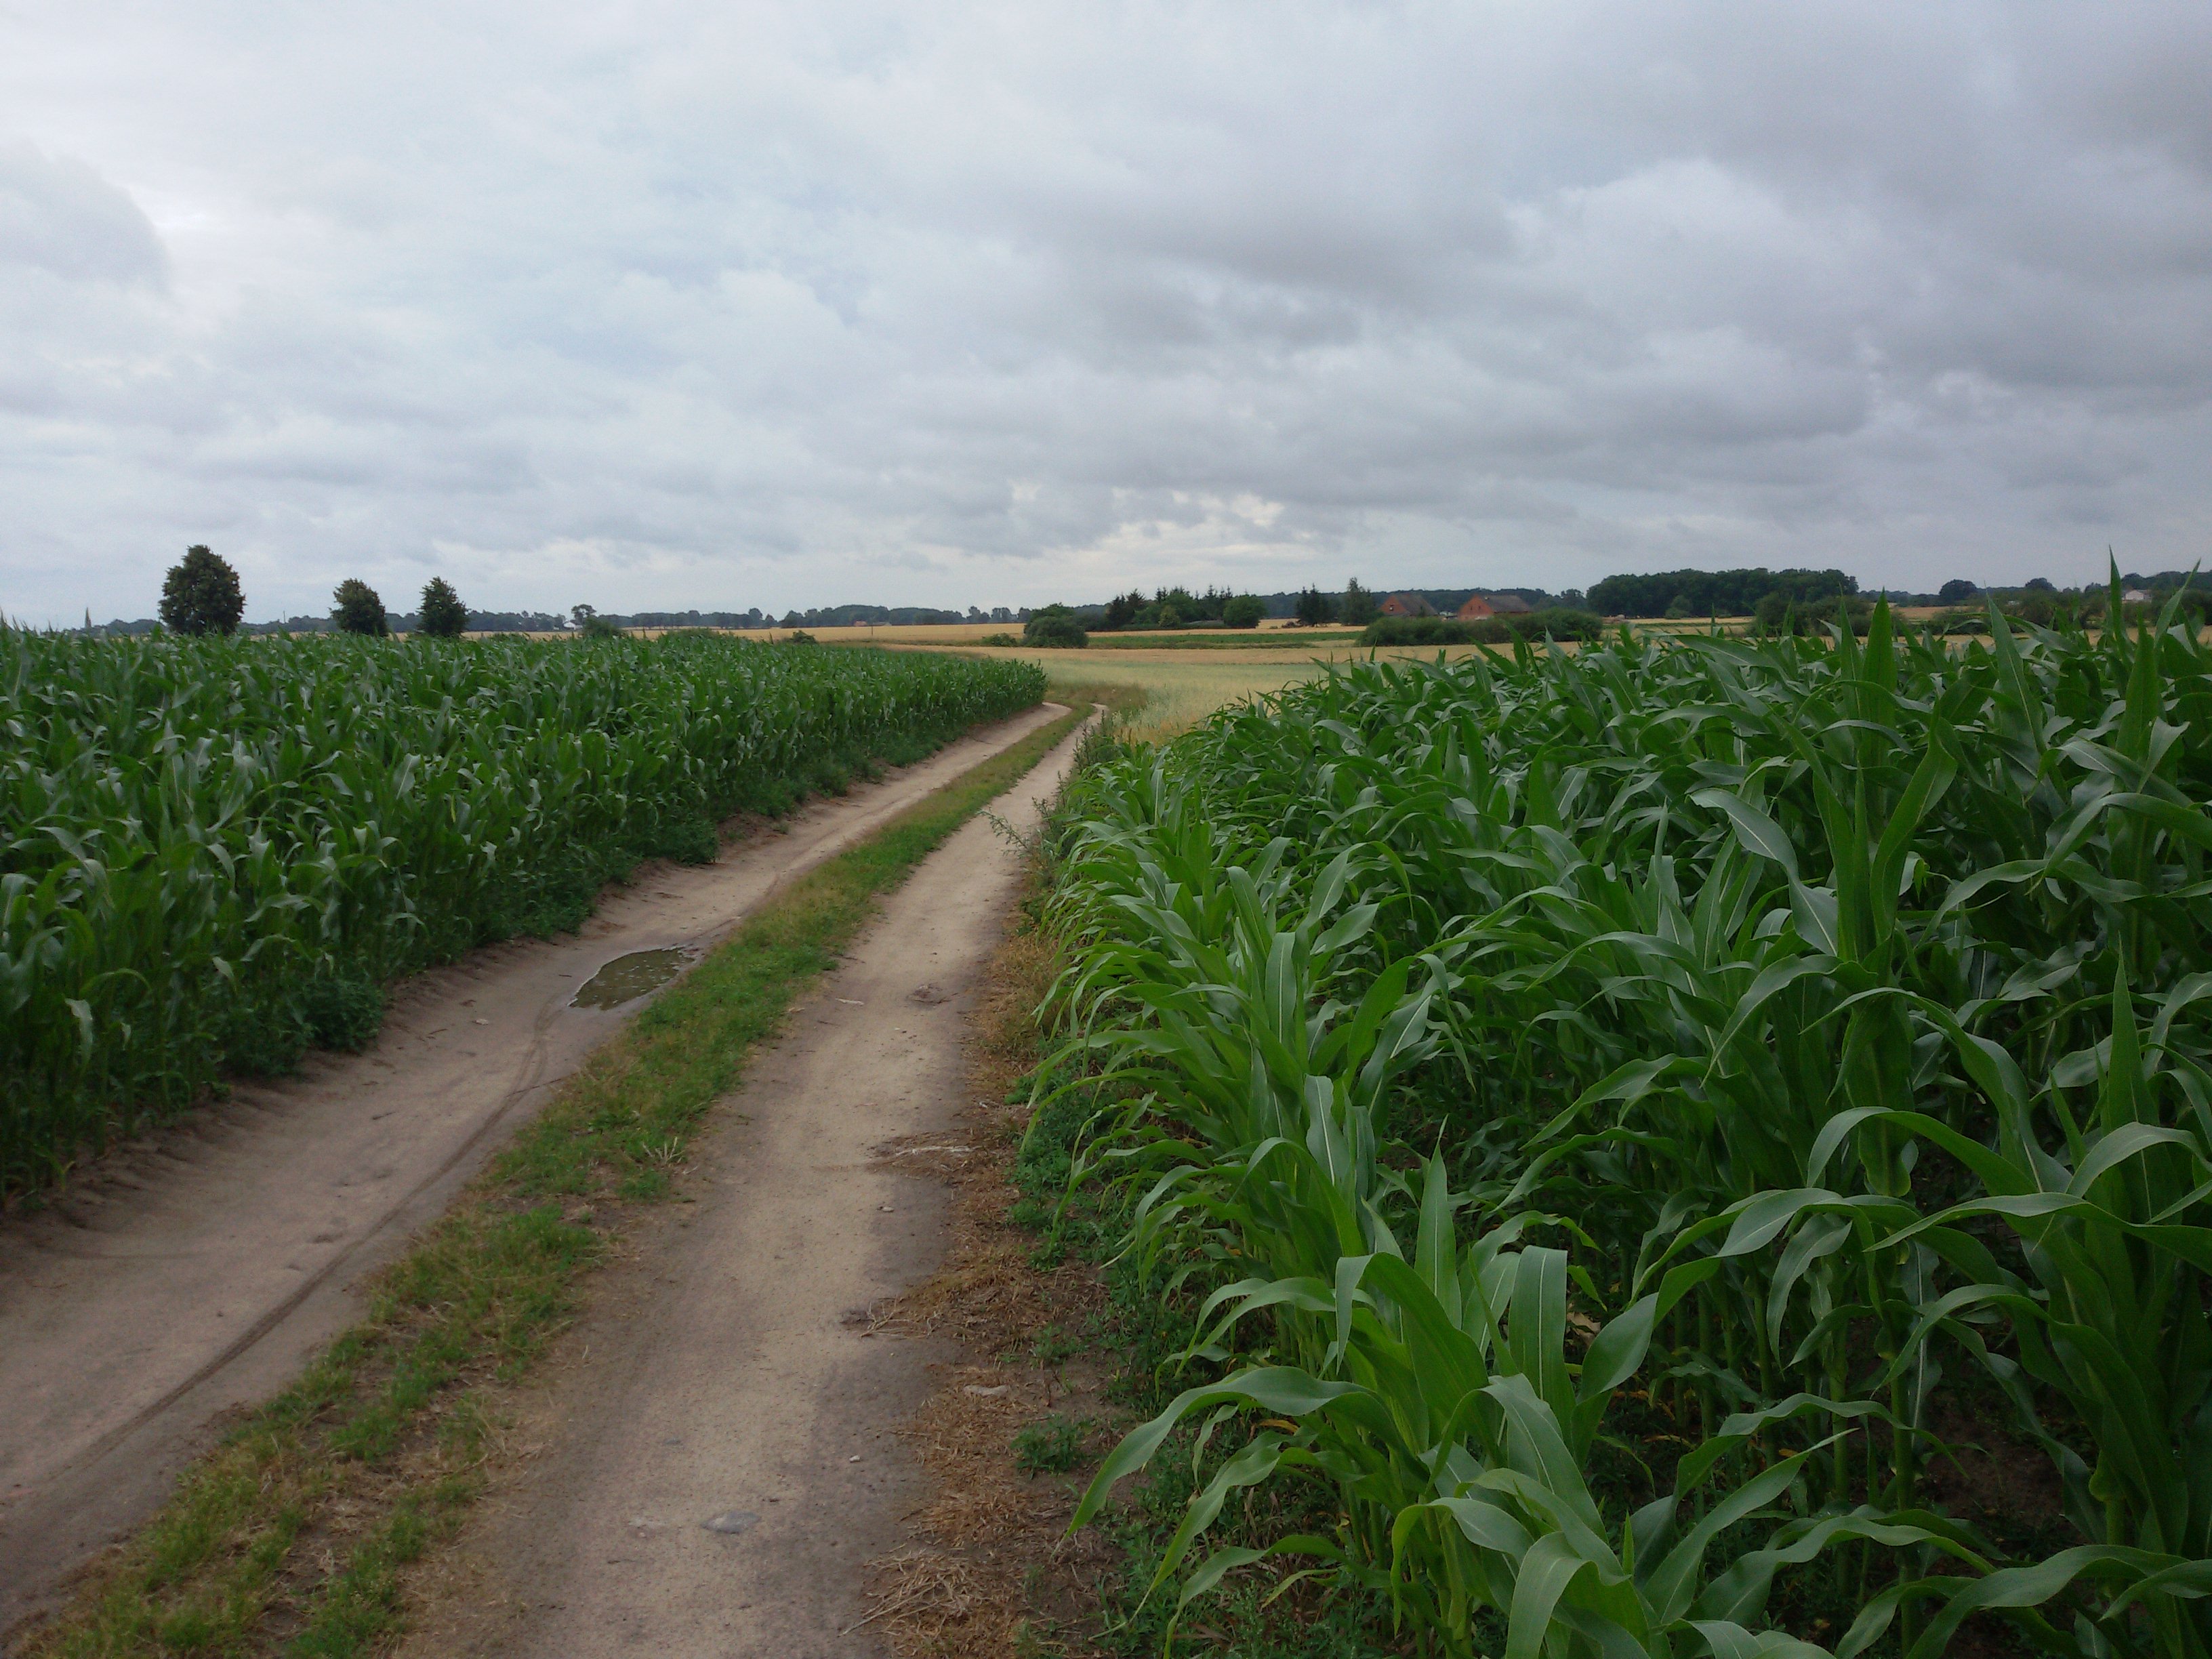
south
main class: Cropland
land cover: Maize
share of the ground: > 75 %
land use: Agriculture (excluding fallow land and kitchen gardens)
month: July
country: PL
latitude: 52.8540
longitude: 17.6313
